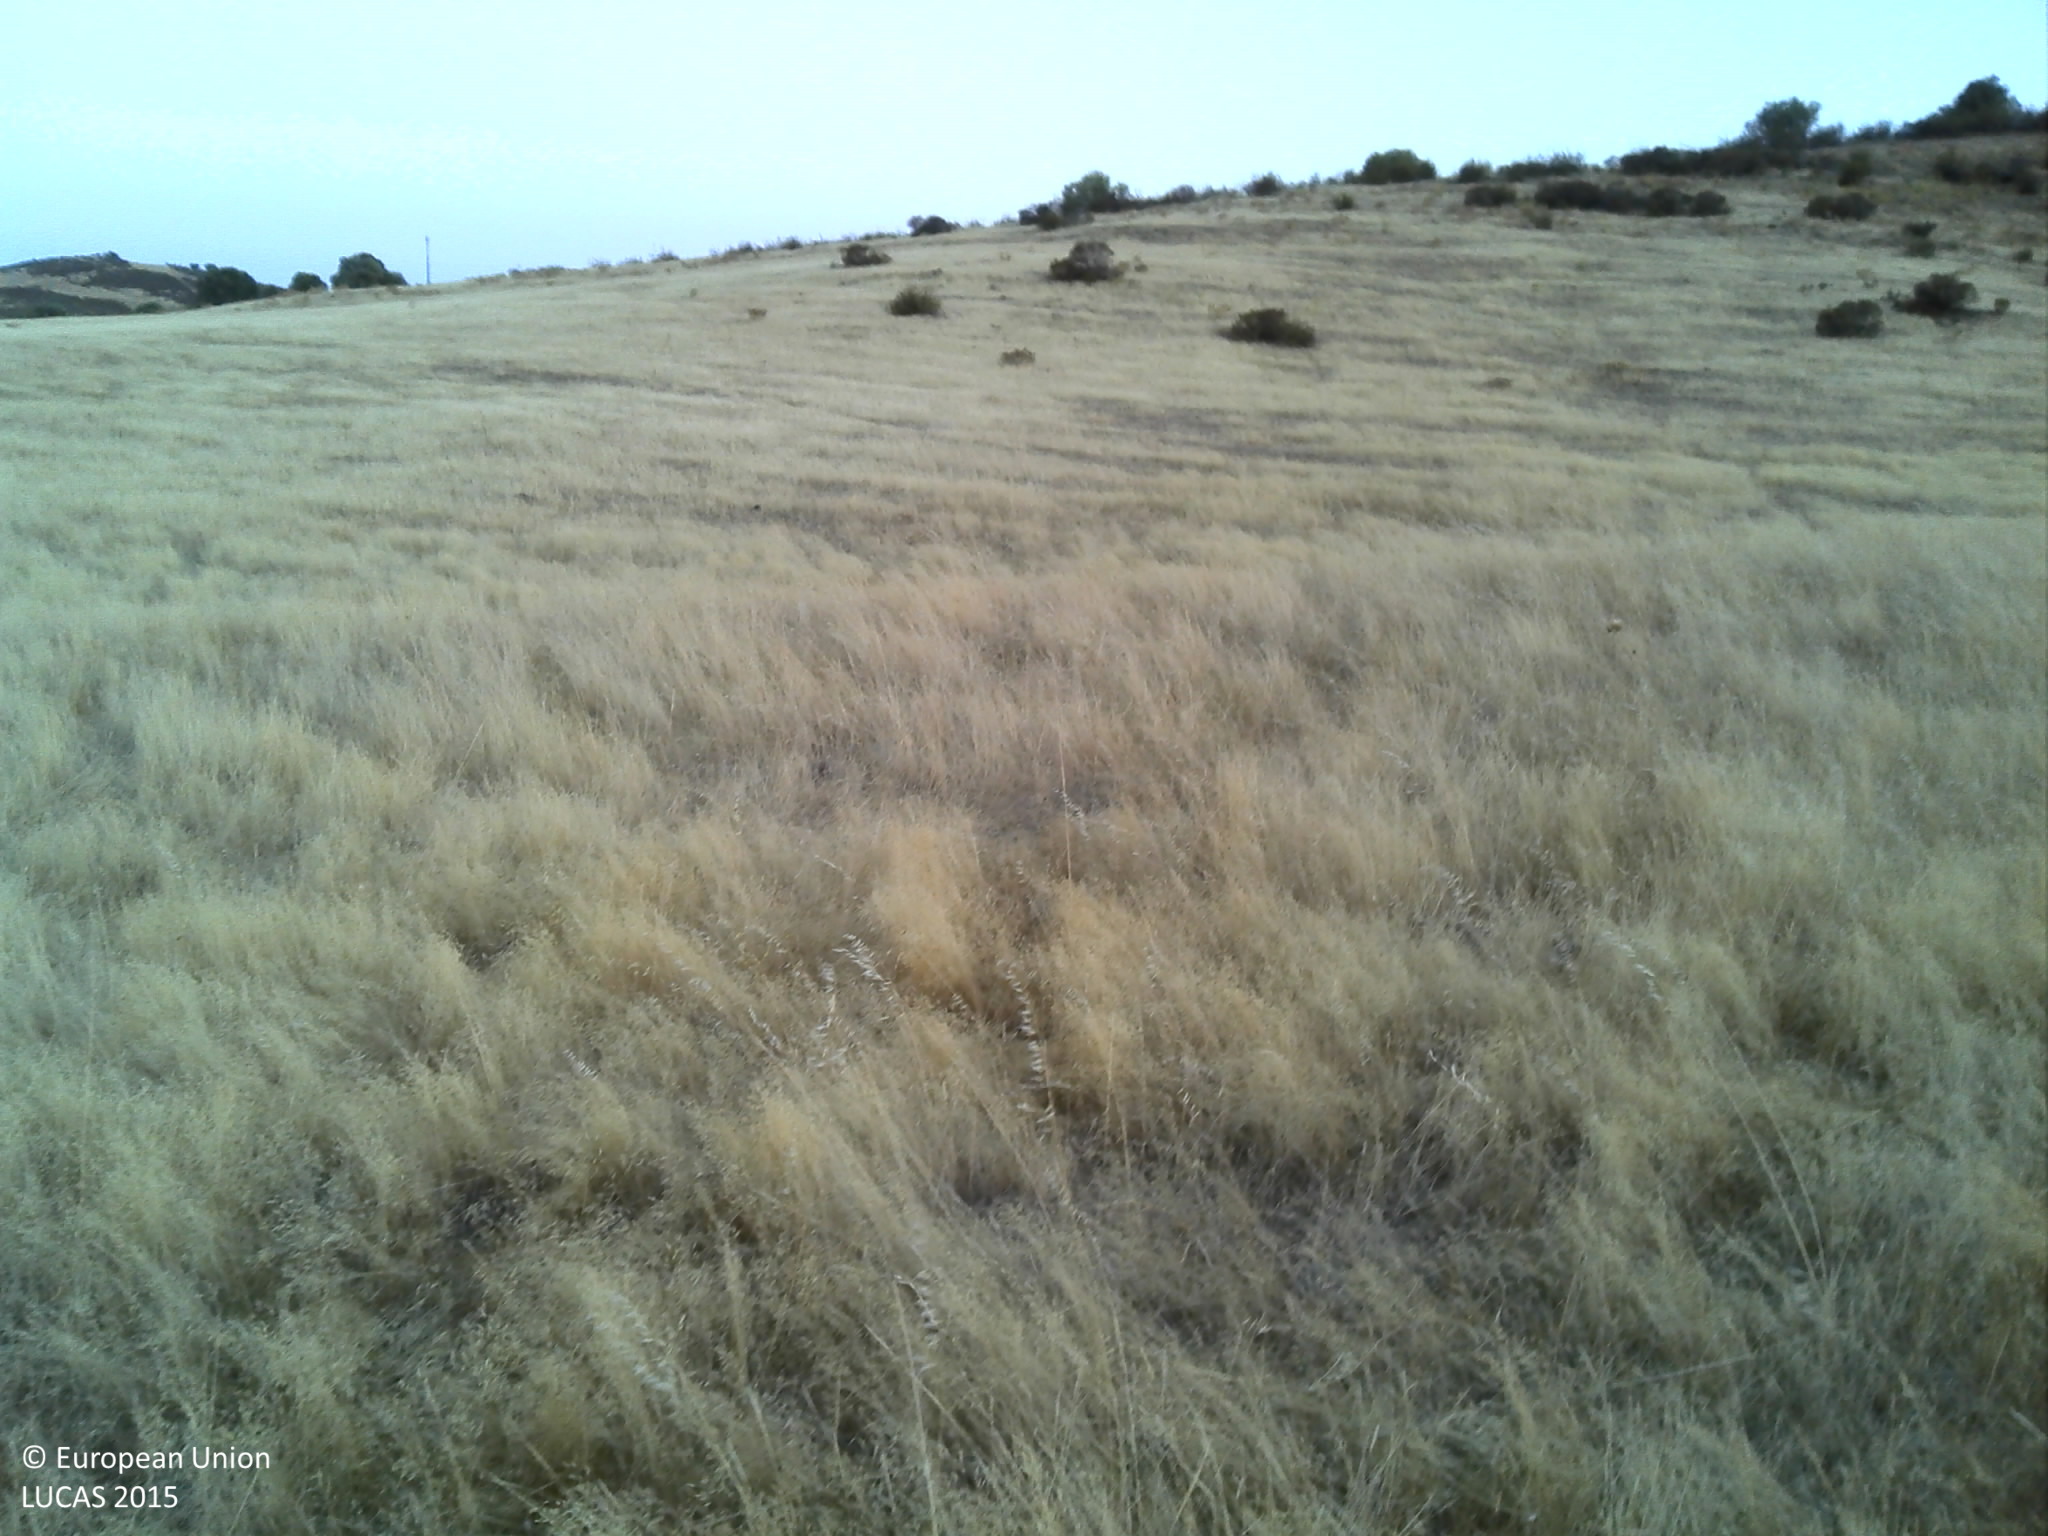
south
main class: Grassland
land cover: Grassland without tree/shrub cover
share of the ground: 50 - 75 %
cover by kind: herbaceous plants 65 %, unconsolidated bare surface 35 %
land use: Agriculture (excluding fallow land and kitchen gardens)
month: July
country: PT
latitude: 37.6012
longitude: -7.8358
